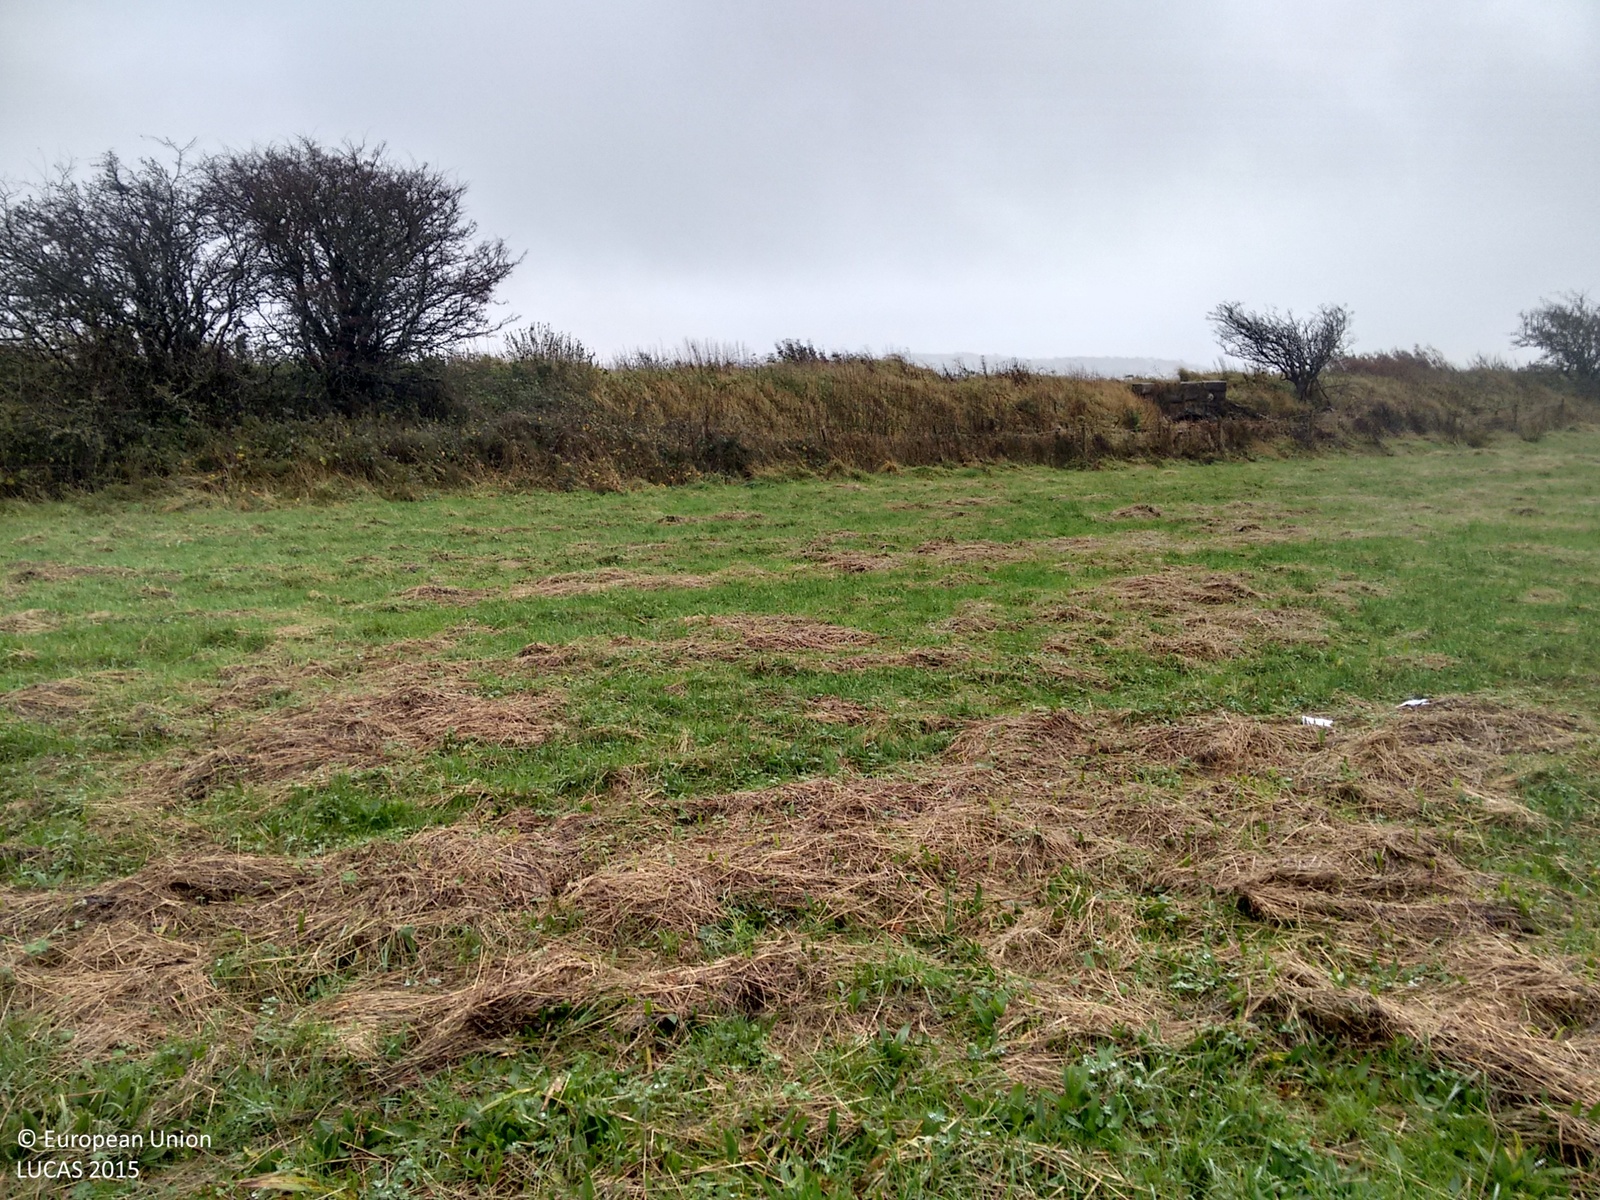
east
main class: Grassland
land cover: Grassland without tree/shrub cover
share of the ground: > 75 %
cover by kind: herbaceous plants 100 %
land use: Agriculture (excluding fallow land and kitchen gardens)
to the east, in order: Grassland without tree/shrub cover; Fences; Managed hedges; Grassland without tree/shrub cover; Tracks; Grassland without tree/shrub cover; Managed hedges; Fences; Grassland without tree/shrub cover
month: November
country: GB
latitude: 54.5342
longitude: -3.5434
